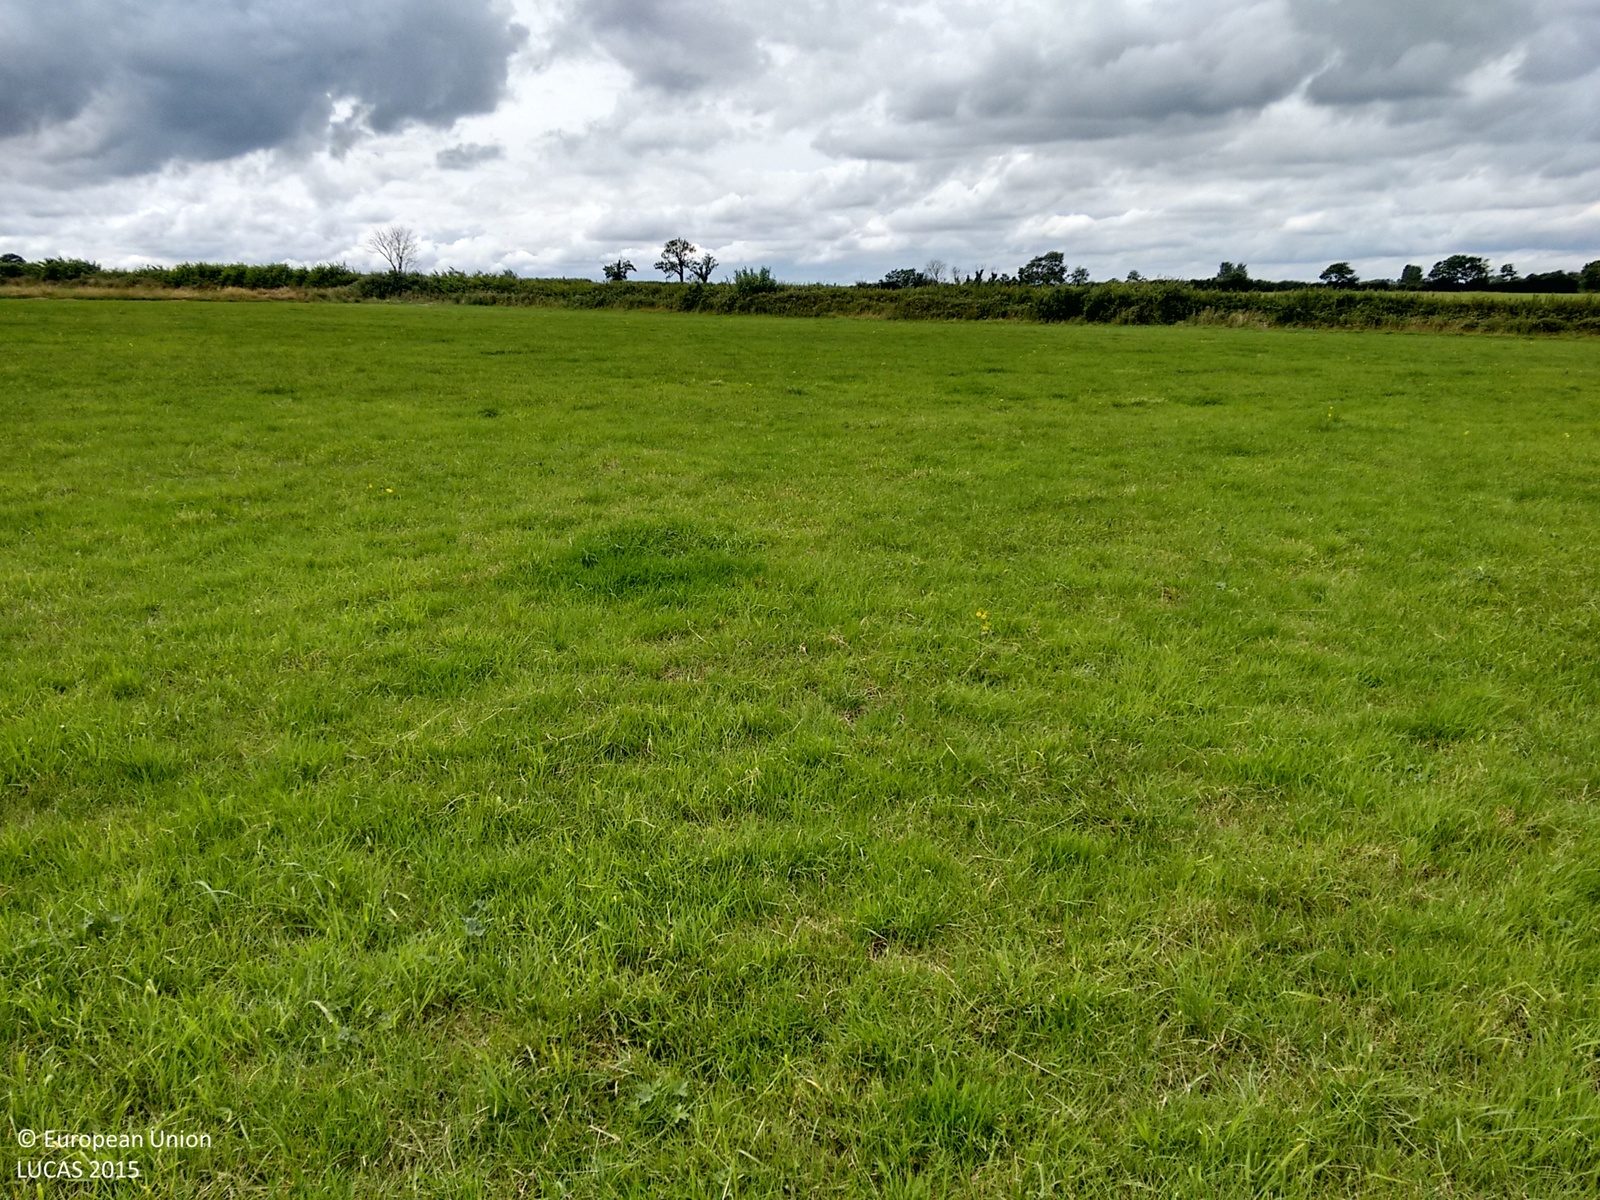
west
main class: Grassland
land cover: Grassland without tree/shrub cover
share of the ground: > 75 %
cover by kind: herbaceous plants 100 %
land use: Agriculture (excluding fallow land and kitchen gardens)
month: July
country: GB
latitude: 52.6899
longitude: -0.7074
